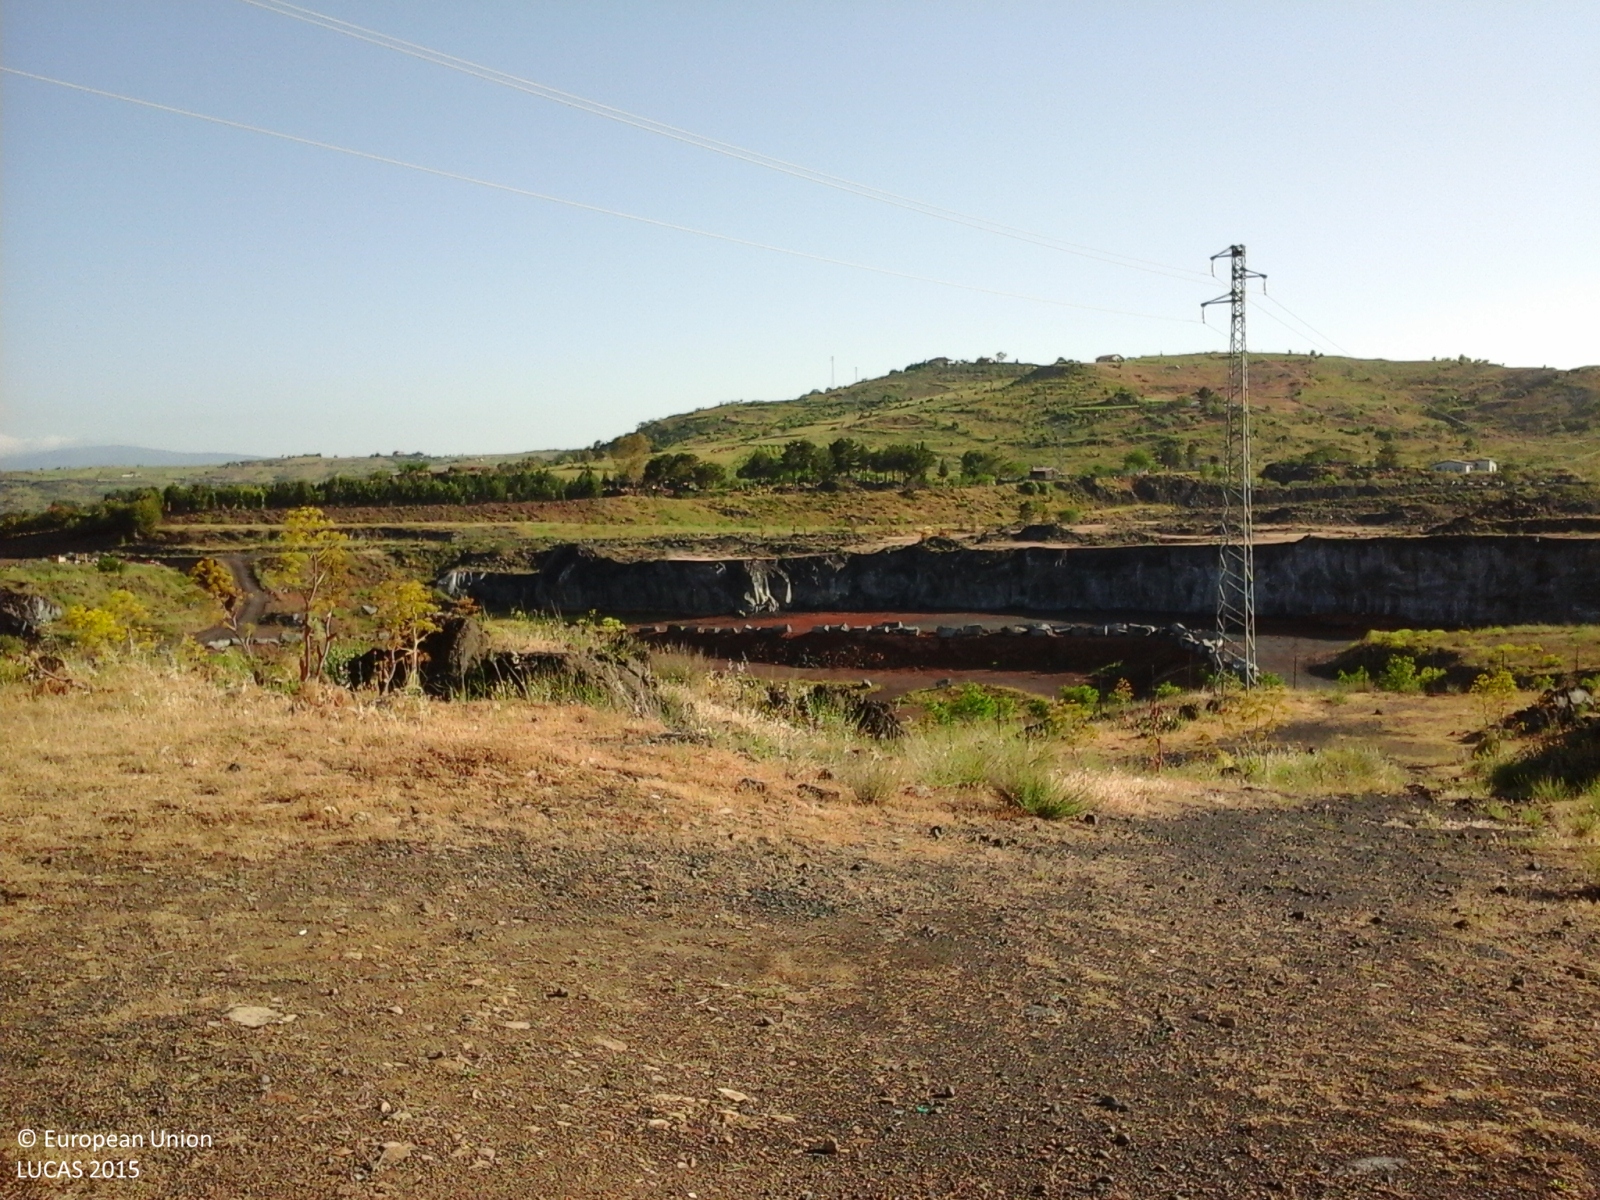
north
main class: Woodland
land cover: Broadleaved woodland
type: thermophilous deciduous forest
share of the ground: > 75 %
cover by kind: broadleaved forest trees 100 %
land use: Forestry
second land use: Amenities, museums, leisure
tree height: > 5 m
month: May
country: IT
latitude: 37.7869
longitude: 14.8604
